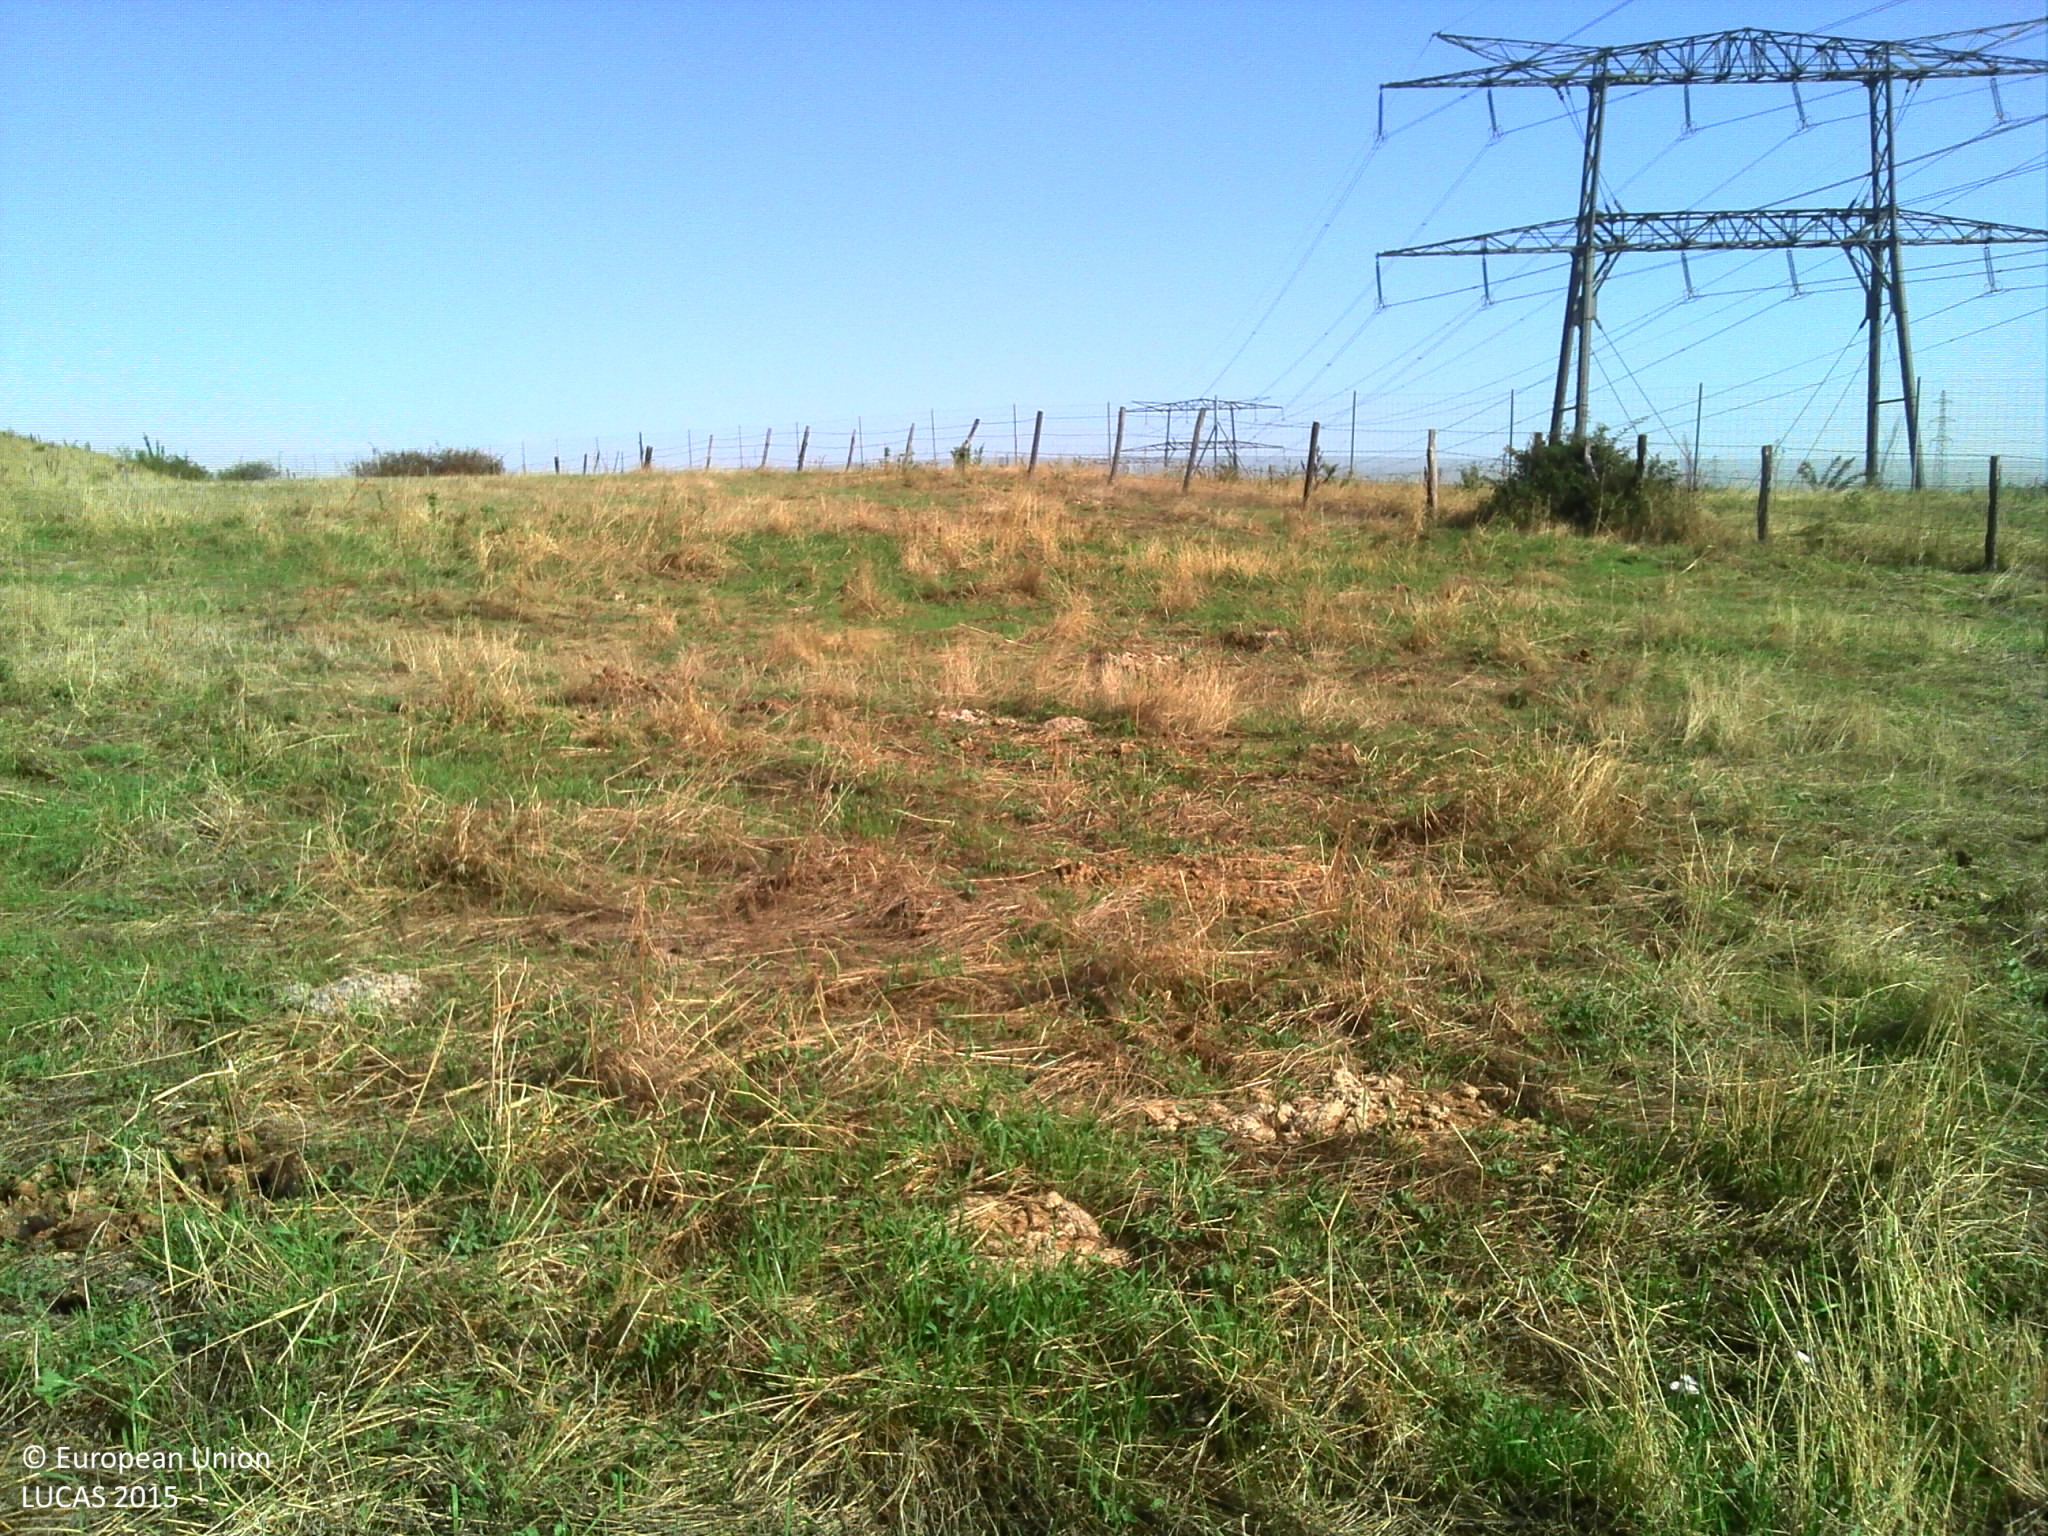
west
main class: Grassland
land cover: Grassland without tree/shrub cover
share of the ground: > 75 %
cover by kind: herbaceous plants 100 %
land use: Agriculture (excluding fallow land and kitchen gardens)
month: August
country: FR
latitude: 45.8221
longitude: 4.6874
